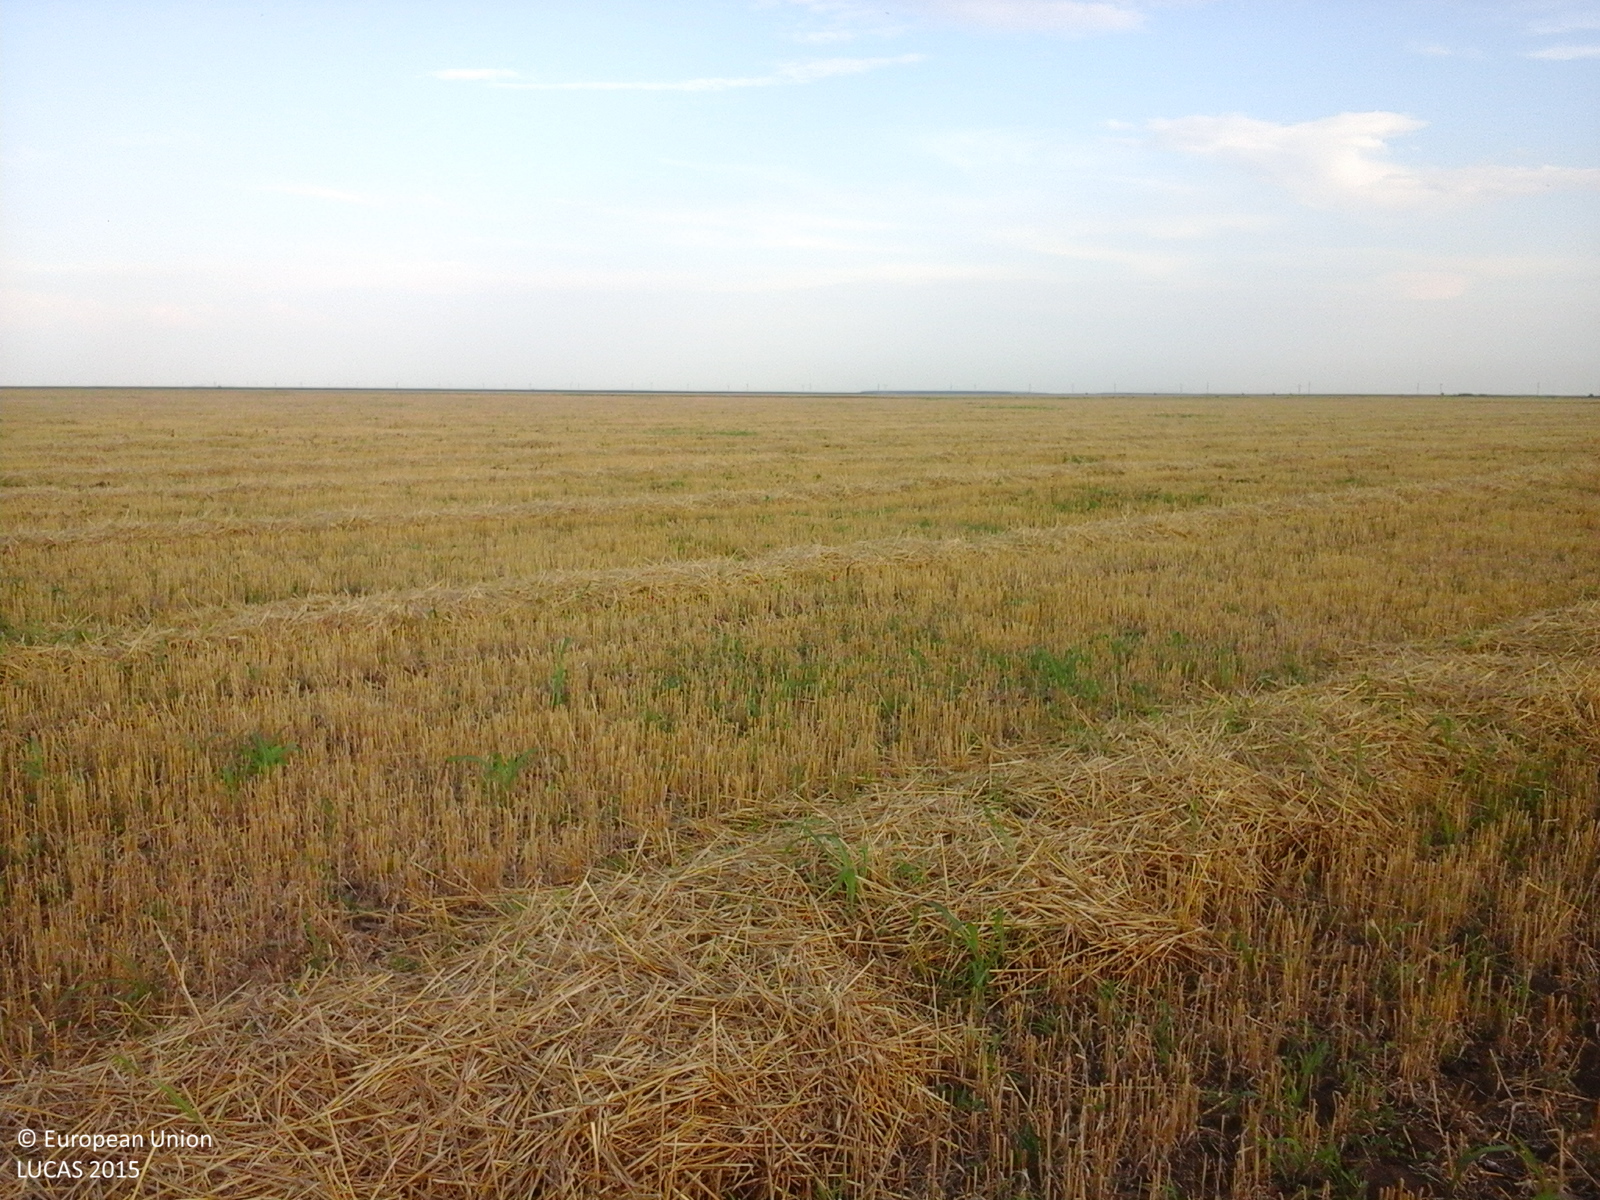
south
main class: Cropland
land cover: Rye
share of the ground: < 10 %
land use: Agriculture (excluding fallow land and kitchen gardens)
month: July
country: RO
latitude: 43.9669
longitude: 25.7339
